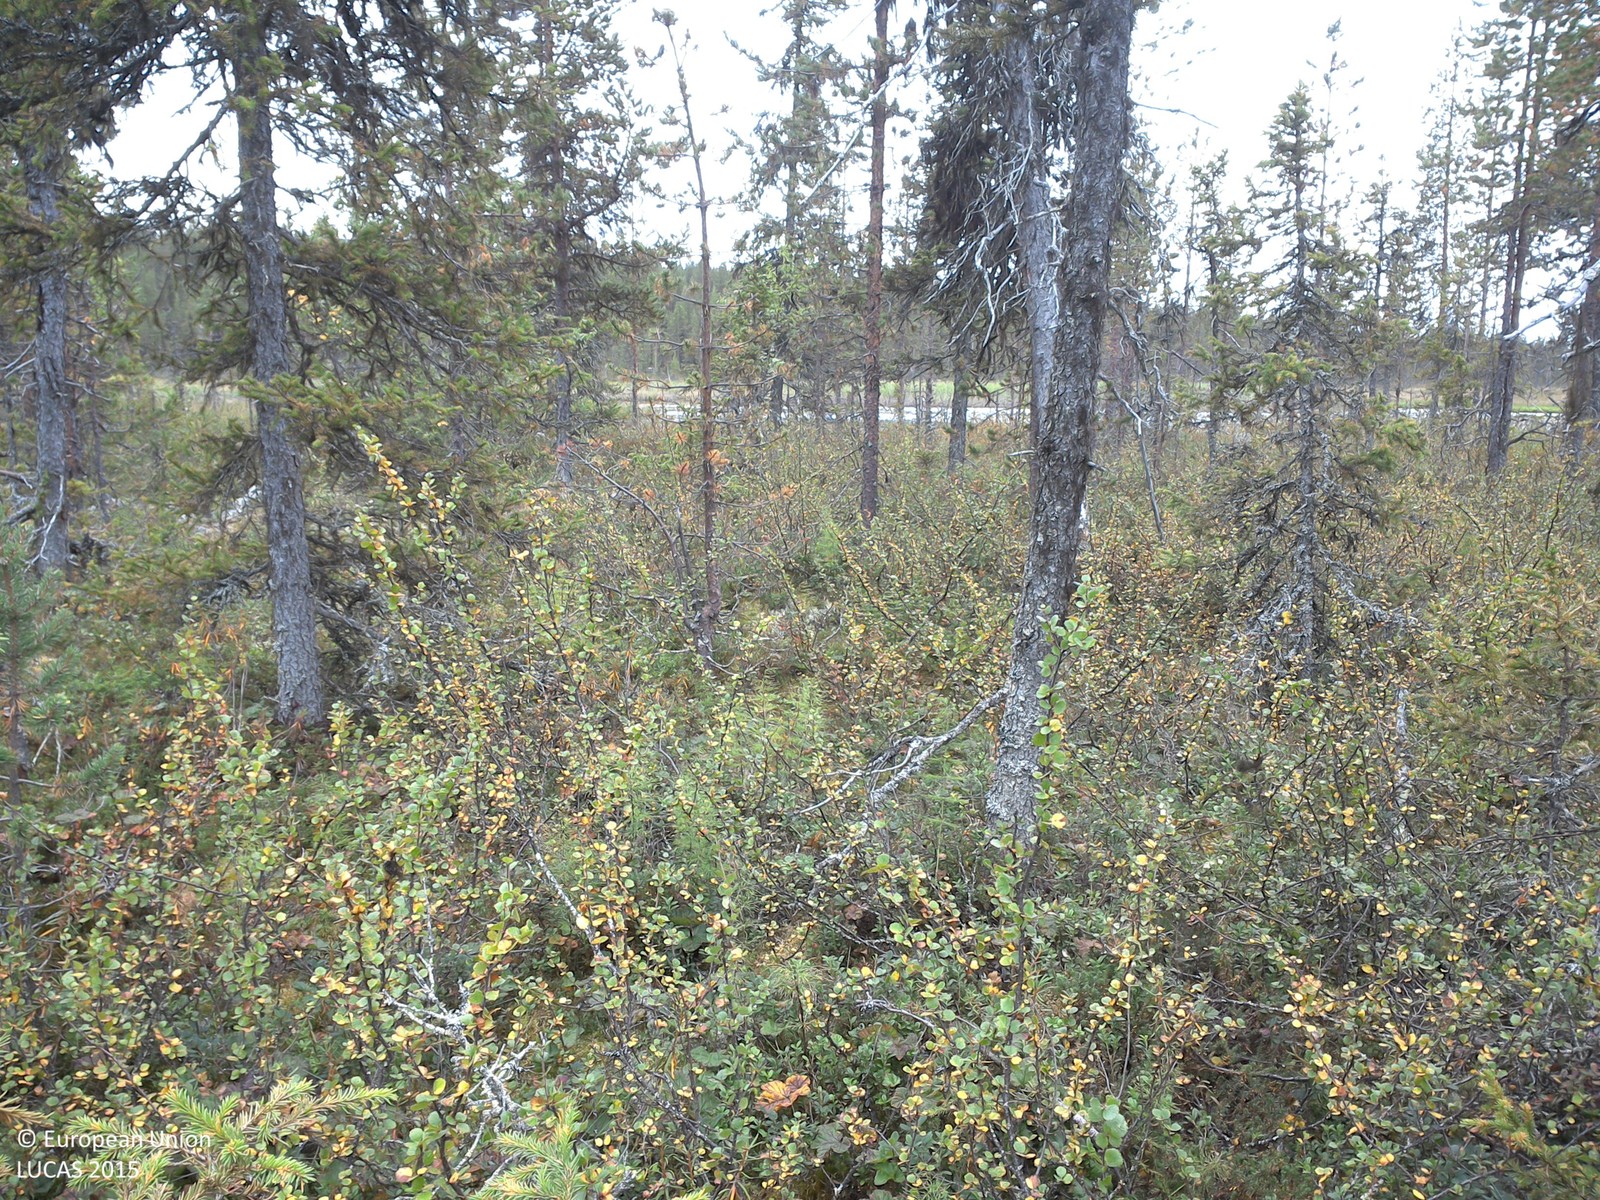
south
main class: Woodland
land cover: Spruce dominated coniferous woodland
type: boreal forest
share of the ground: 10 - 25 %
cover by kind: shrubs 60 %, coniferous forest trees 20 %, lichens and mosses 20 %
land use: Forestry
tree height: > 5 m
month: August
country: SE
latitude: 67.8295
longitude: 21.4618
